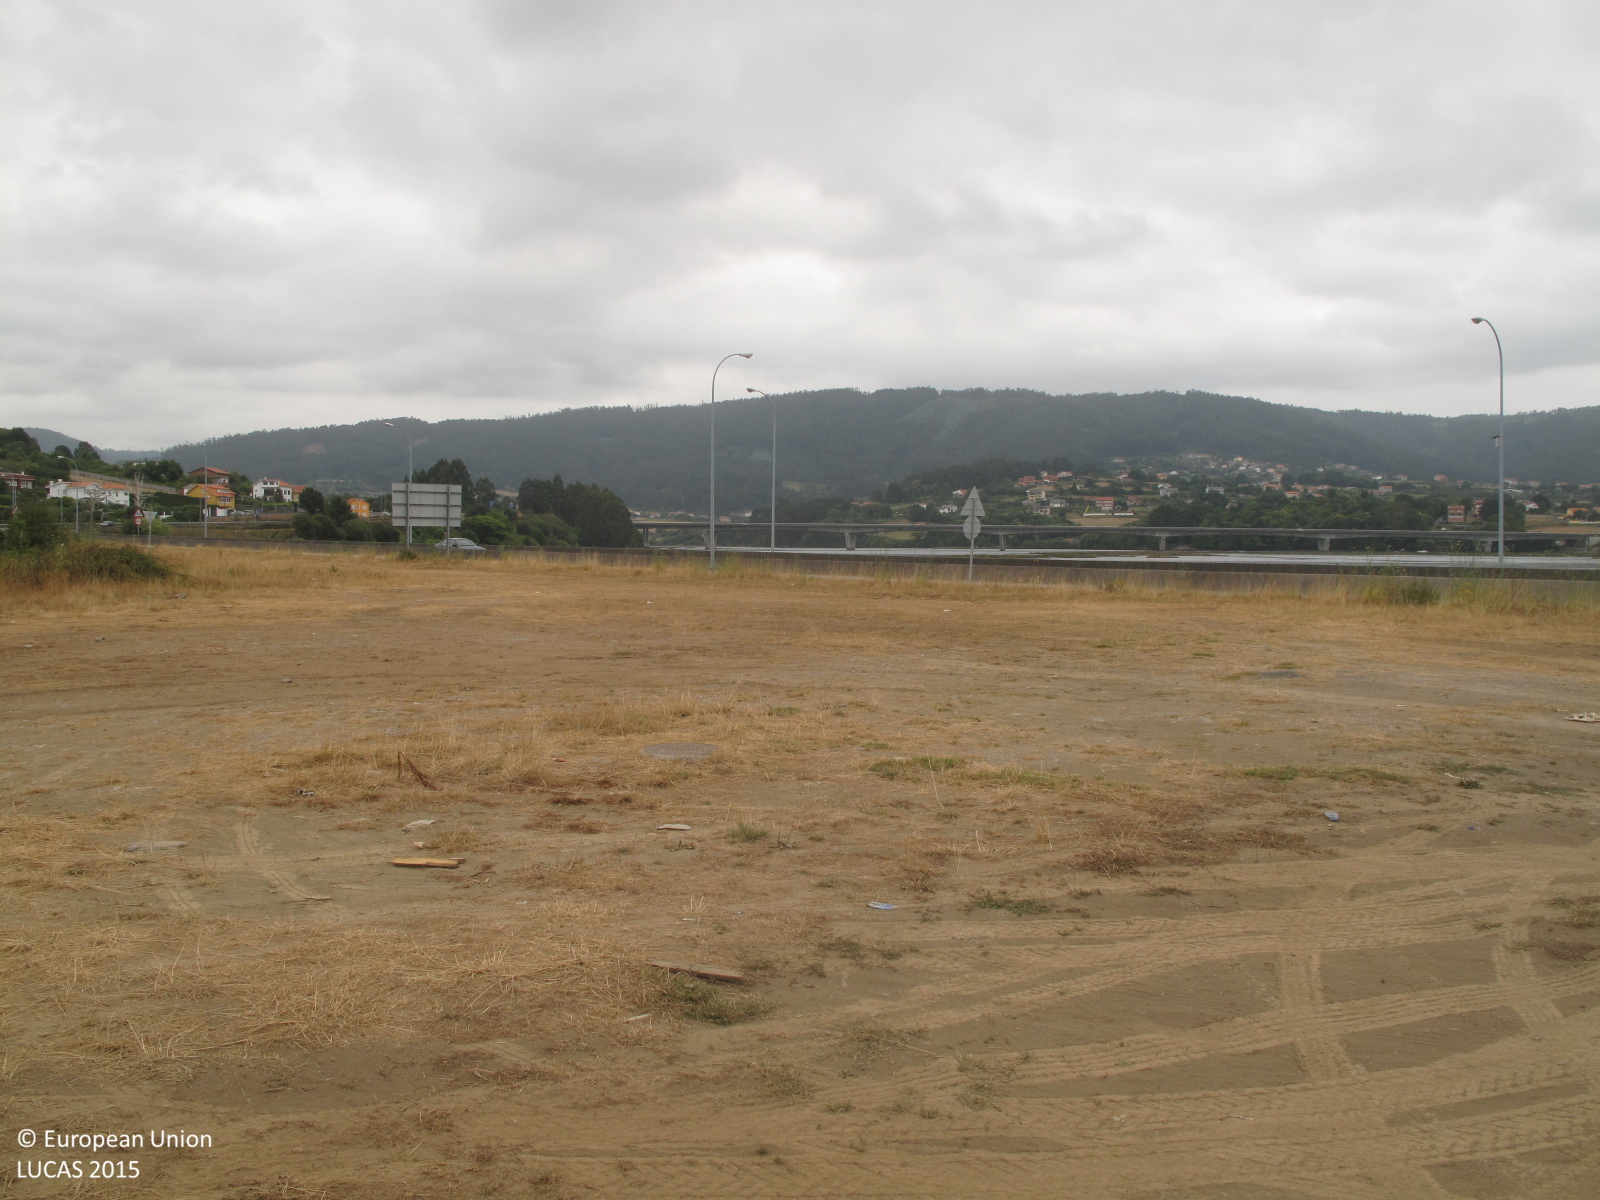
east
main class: Grassland
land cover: Spontaneously vegetated surfaces
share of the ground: 10 - 25 %
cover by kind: unconsolidated bare surface 80 %, herbaceous plants 20 %
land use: Abandoned areas
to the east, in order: Spontaneously vegetated surfaces; Paved roads, cycling and walking lanes; Spontaneously vegetated surfaces; Tracks; Grassland without tree/shrub cover
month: July
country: ES
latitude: 43.4129
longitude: -8.1678
